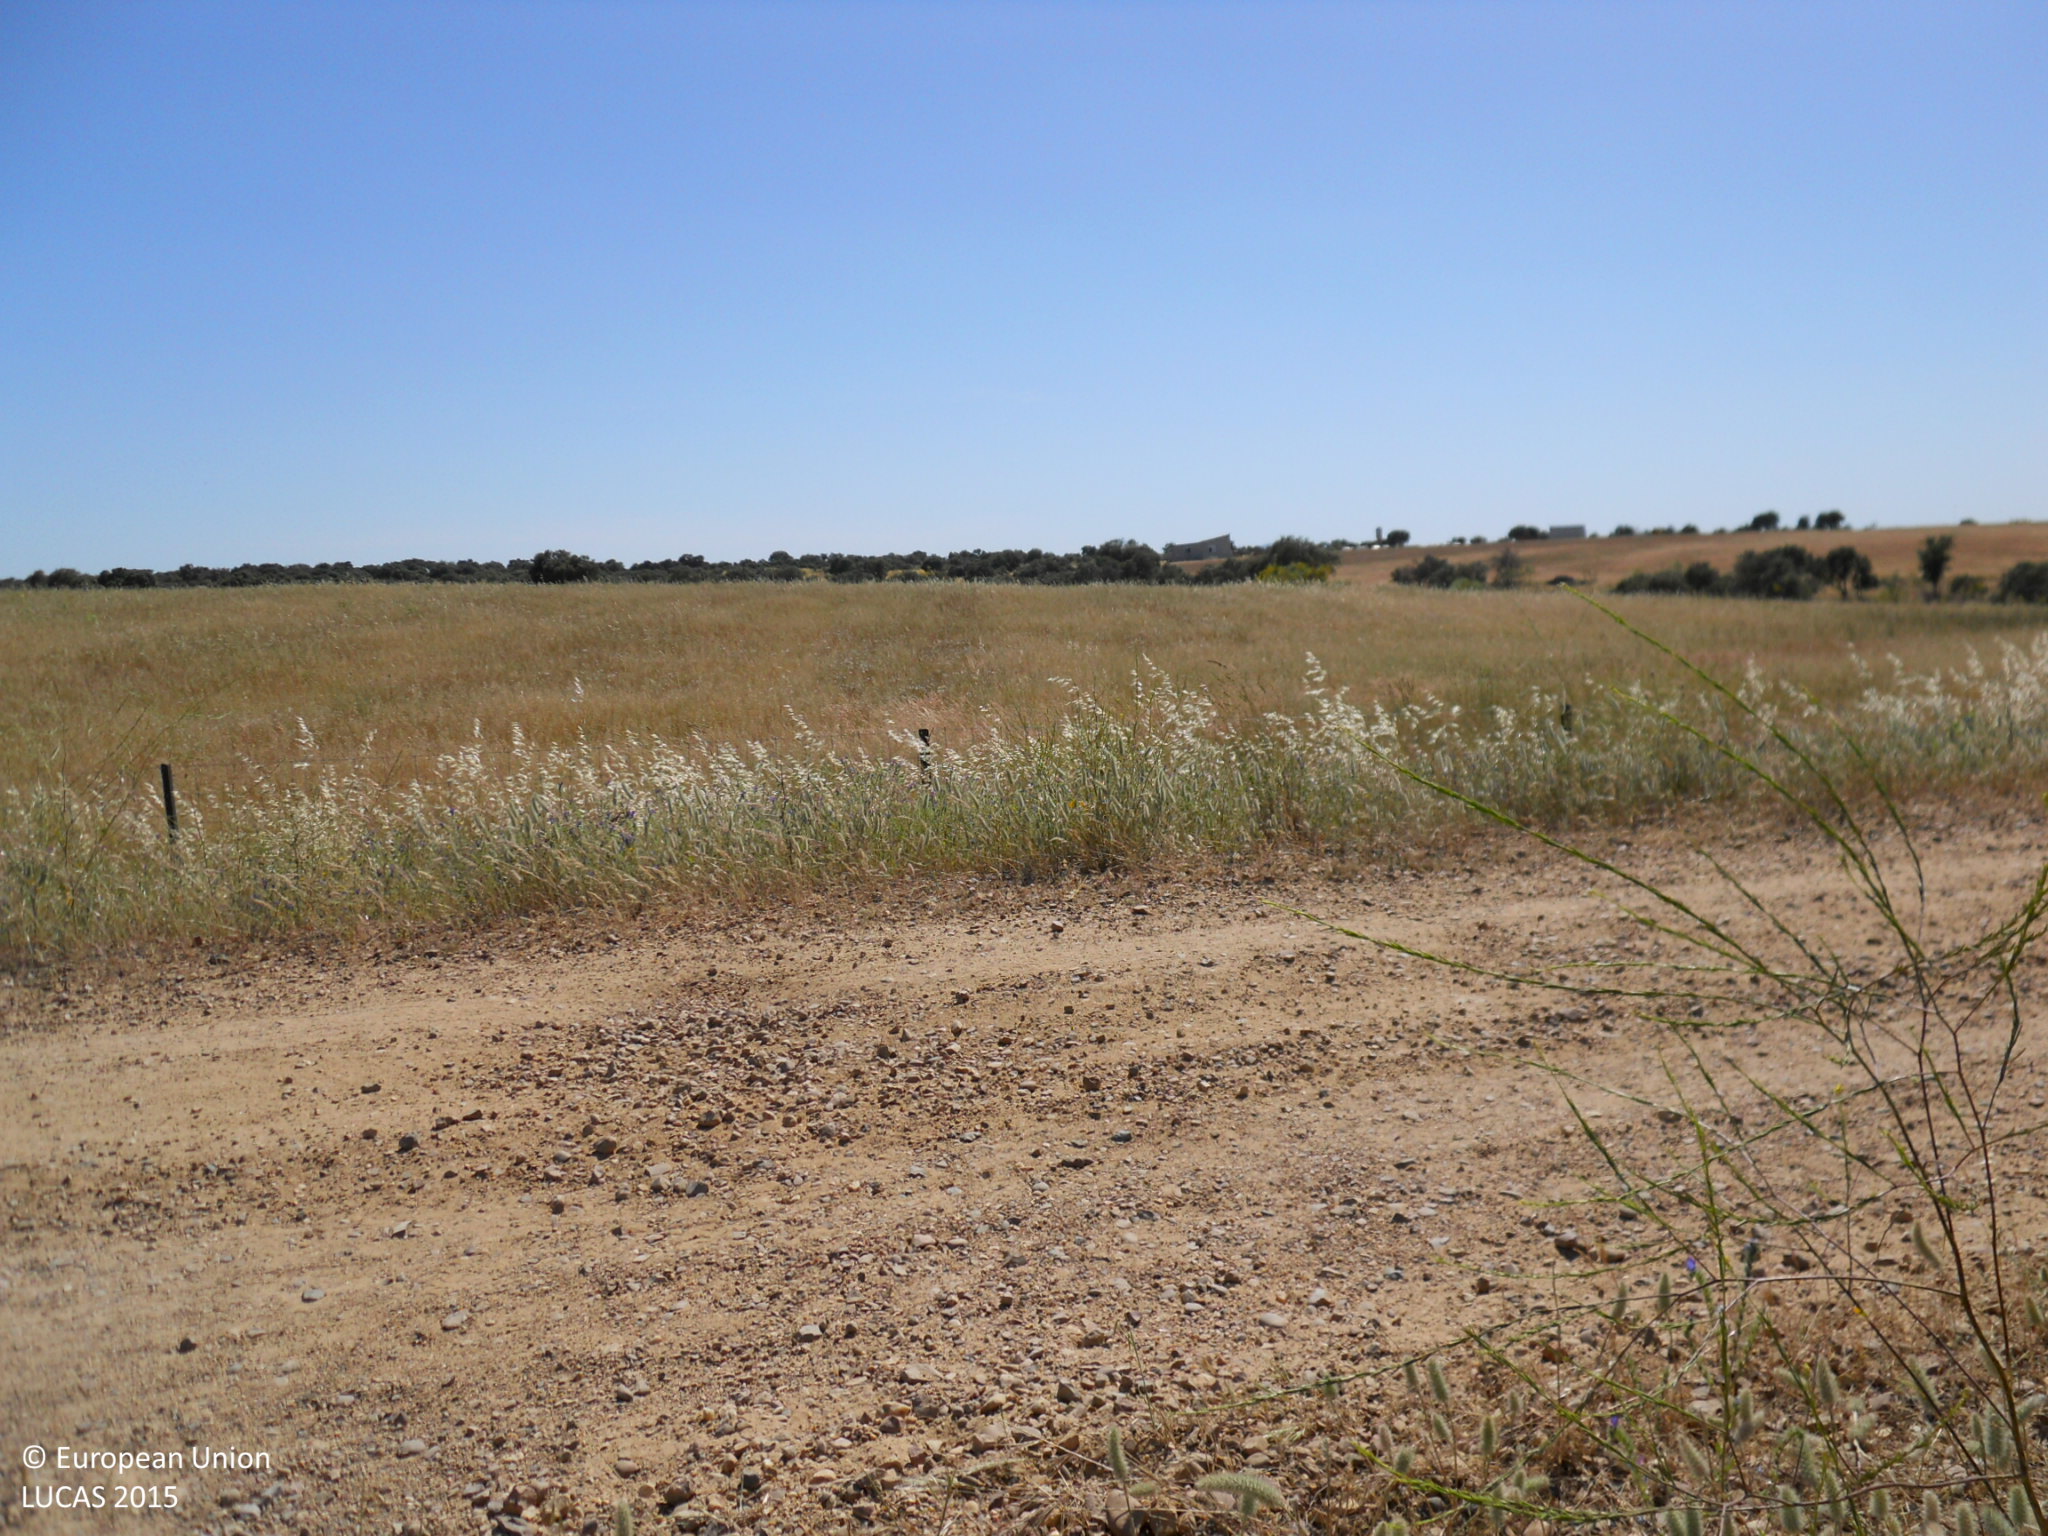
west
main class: Woodland
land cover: Broadleaved woodland
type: broadleaved evergreen forest
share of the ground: 10 - 25 %
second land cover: Grassland without tree/shrub cover
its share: > 75 %
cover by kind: herbaceous plants 85 %, broadleaved forest trees 10 %, shrubs 5 %
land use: Forestry
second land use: Agriculture (excluding fallow land and kitchen gardens)
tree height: > 5 m
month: May
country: ES
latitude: 38.9404
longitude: -6.2426
